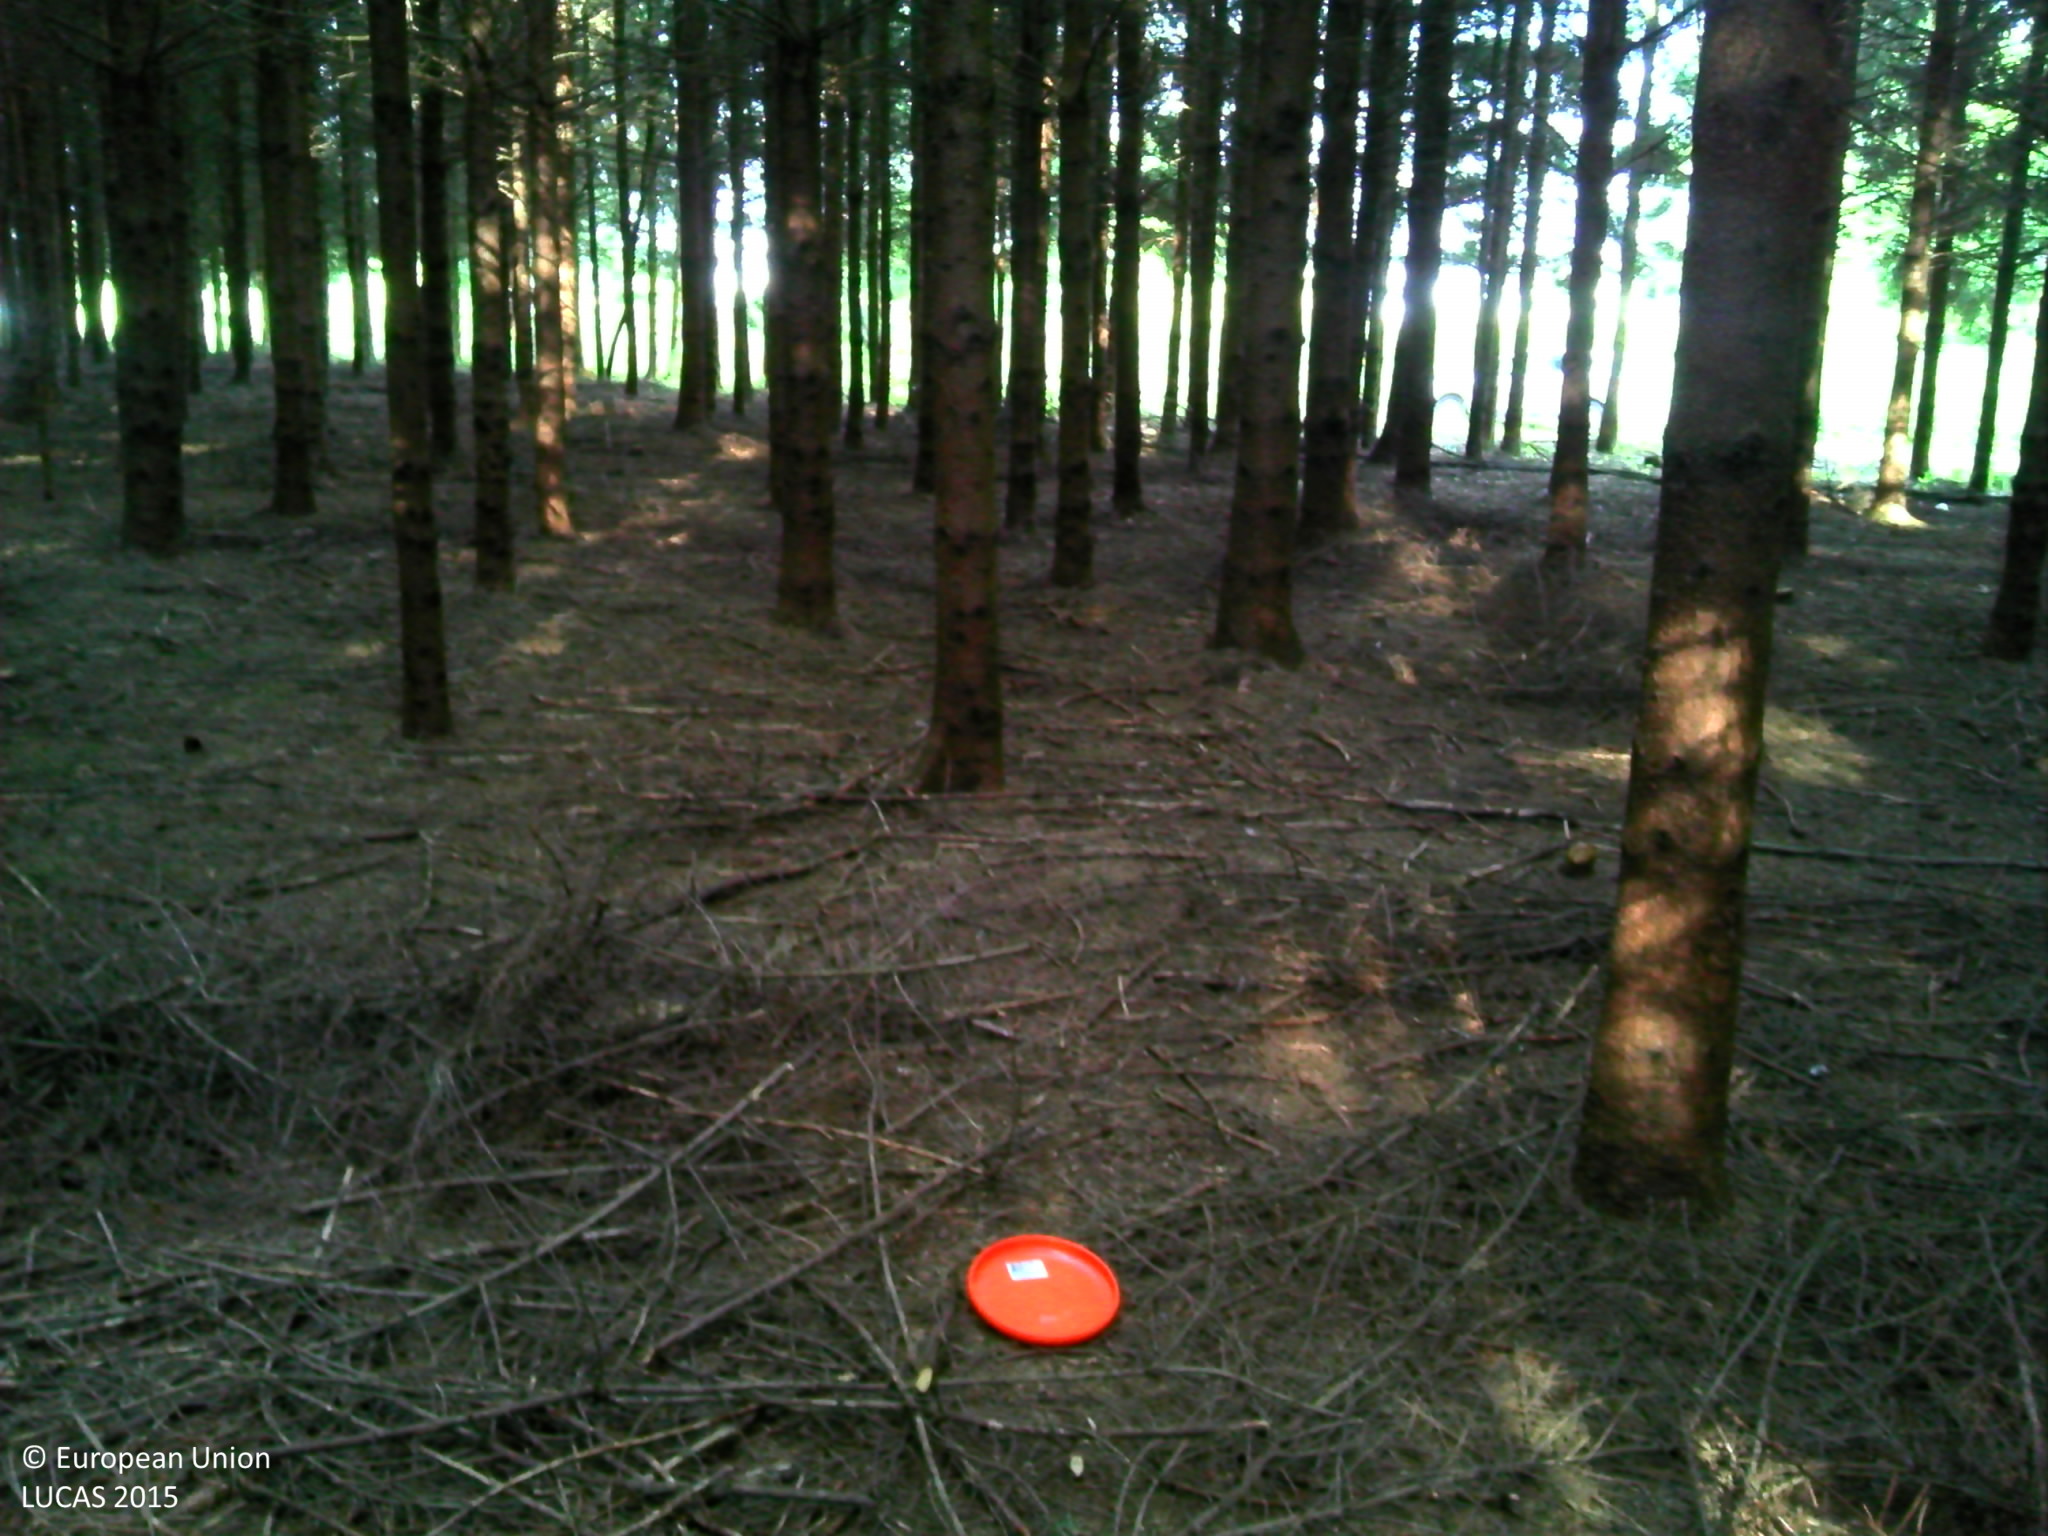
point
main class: Woodland
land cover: Spruce dominated coniferous woodland
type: hemiboreal forest and nemoral coniferous forest and mixed broadleaved-coniferous forest
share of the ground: > 75 %
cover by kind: coniferous forest trees 100 %
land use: Forestry
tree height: > 5 m
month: July
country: BE
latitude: 49.8806
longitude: 5.5312
